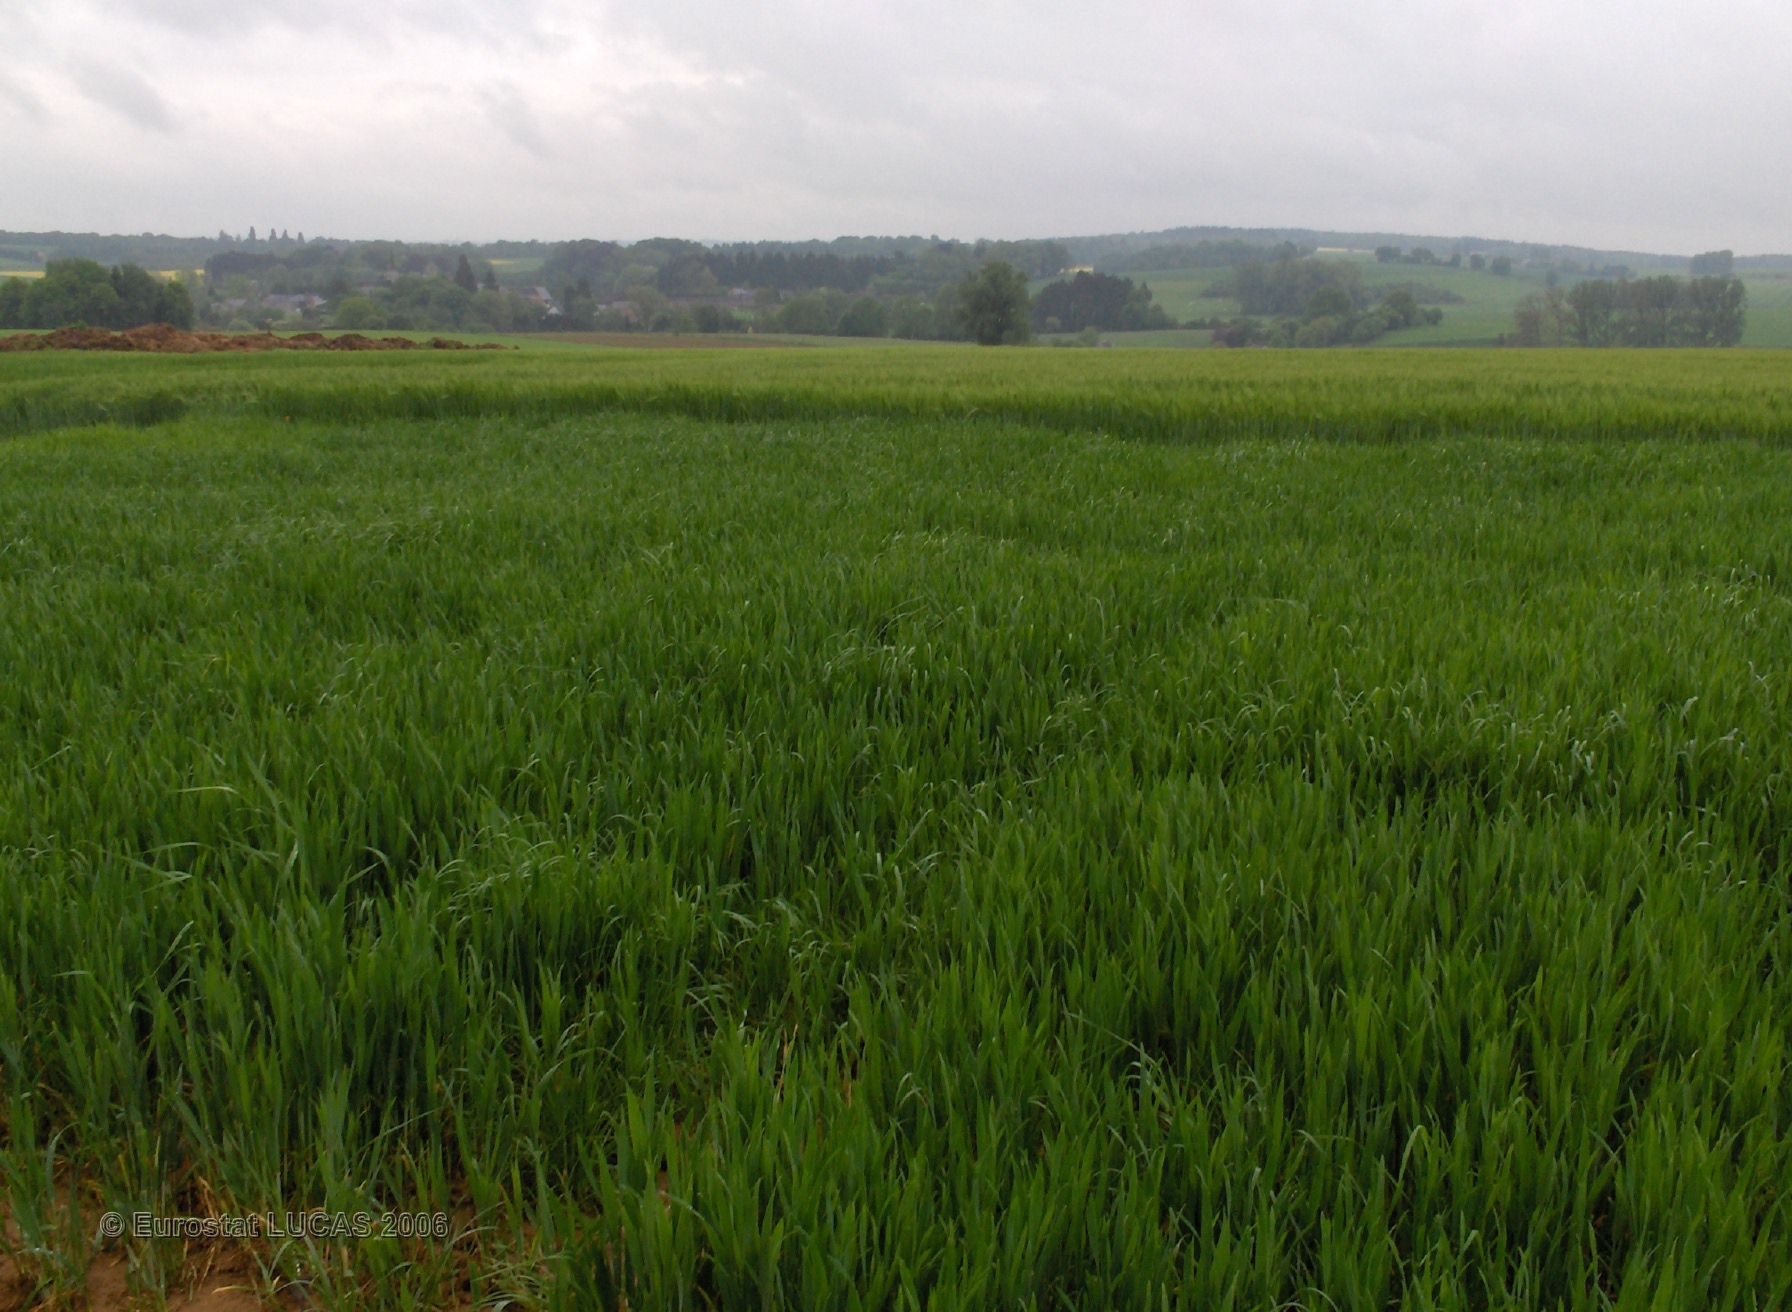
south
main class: Cropland
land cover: Common wheat
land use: Agriculture (excluding fallow land and kitchen gardens)
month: May
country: BE
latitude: 50.3380
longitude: 5.2629
